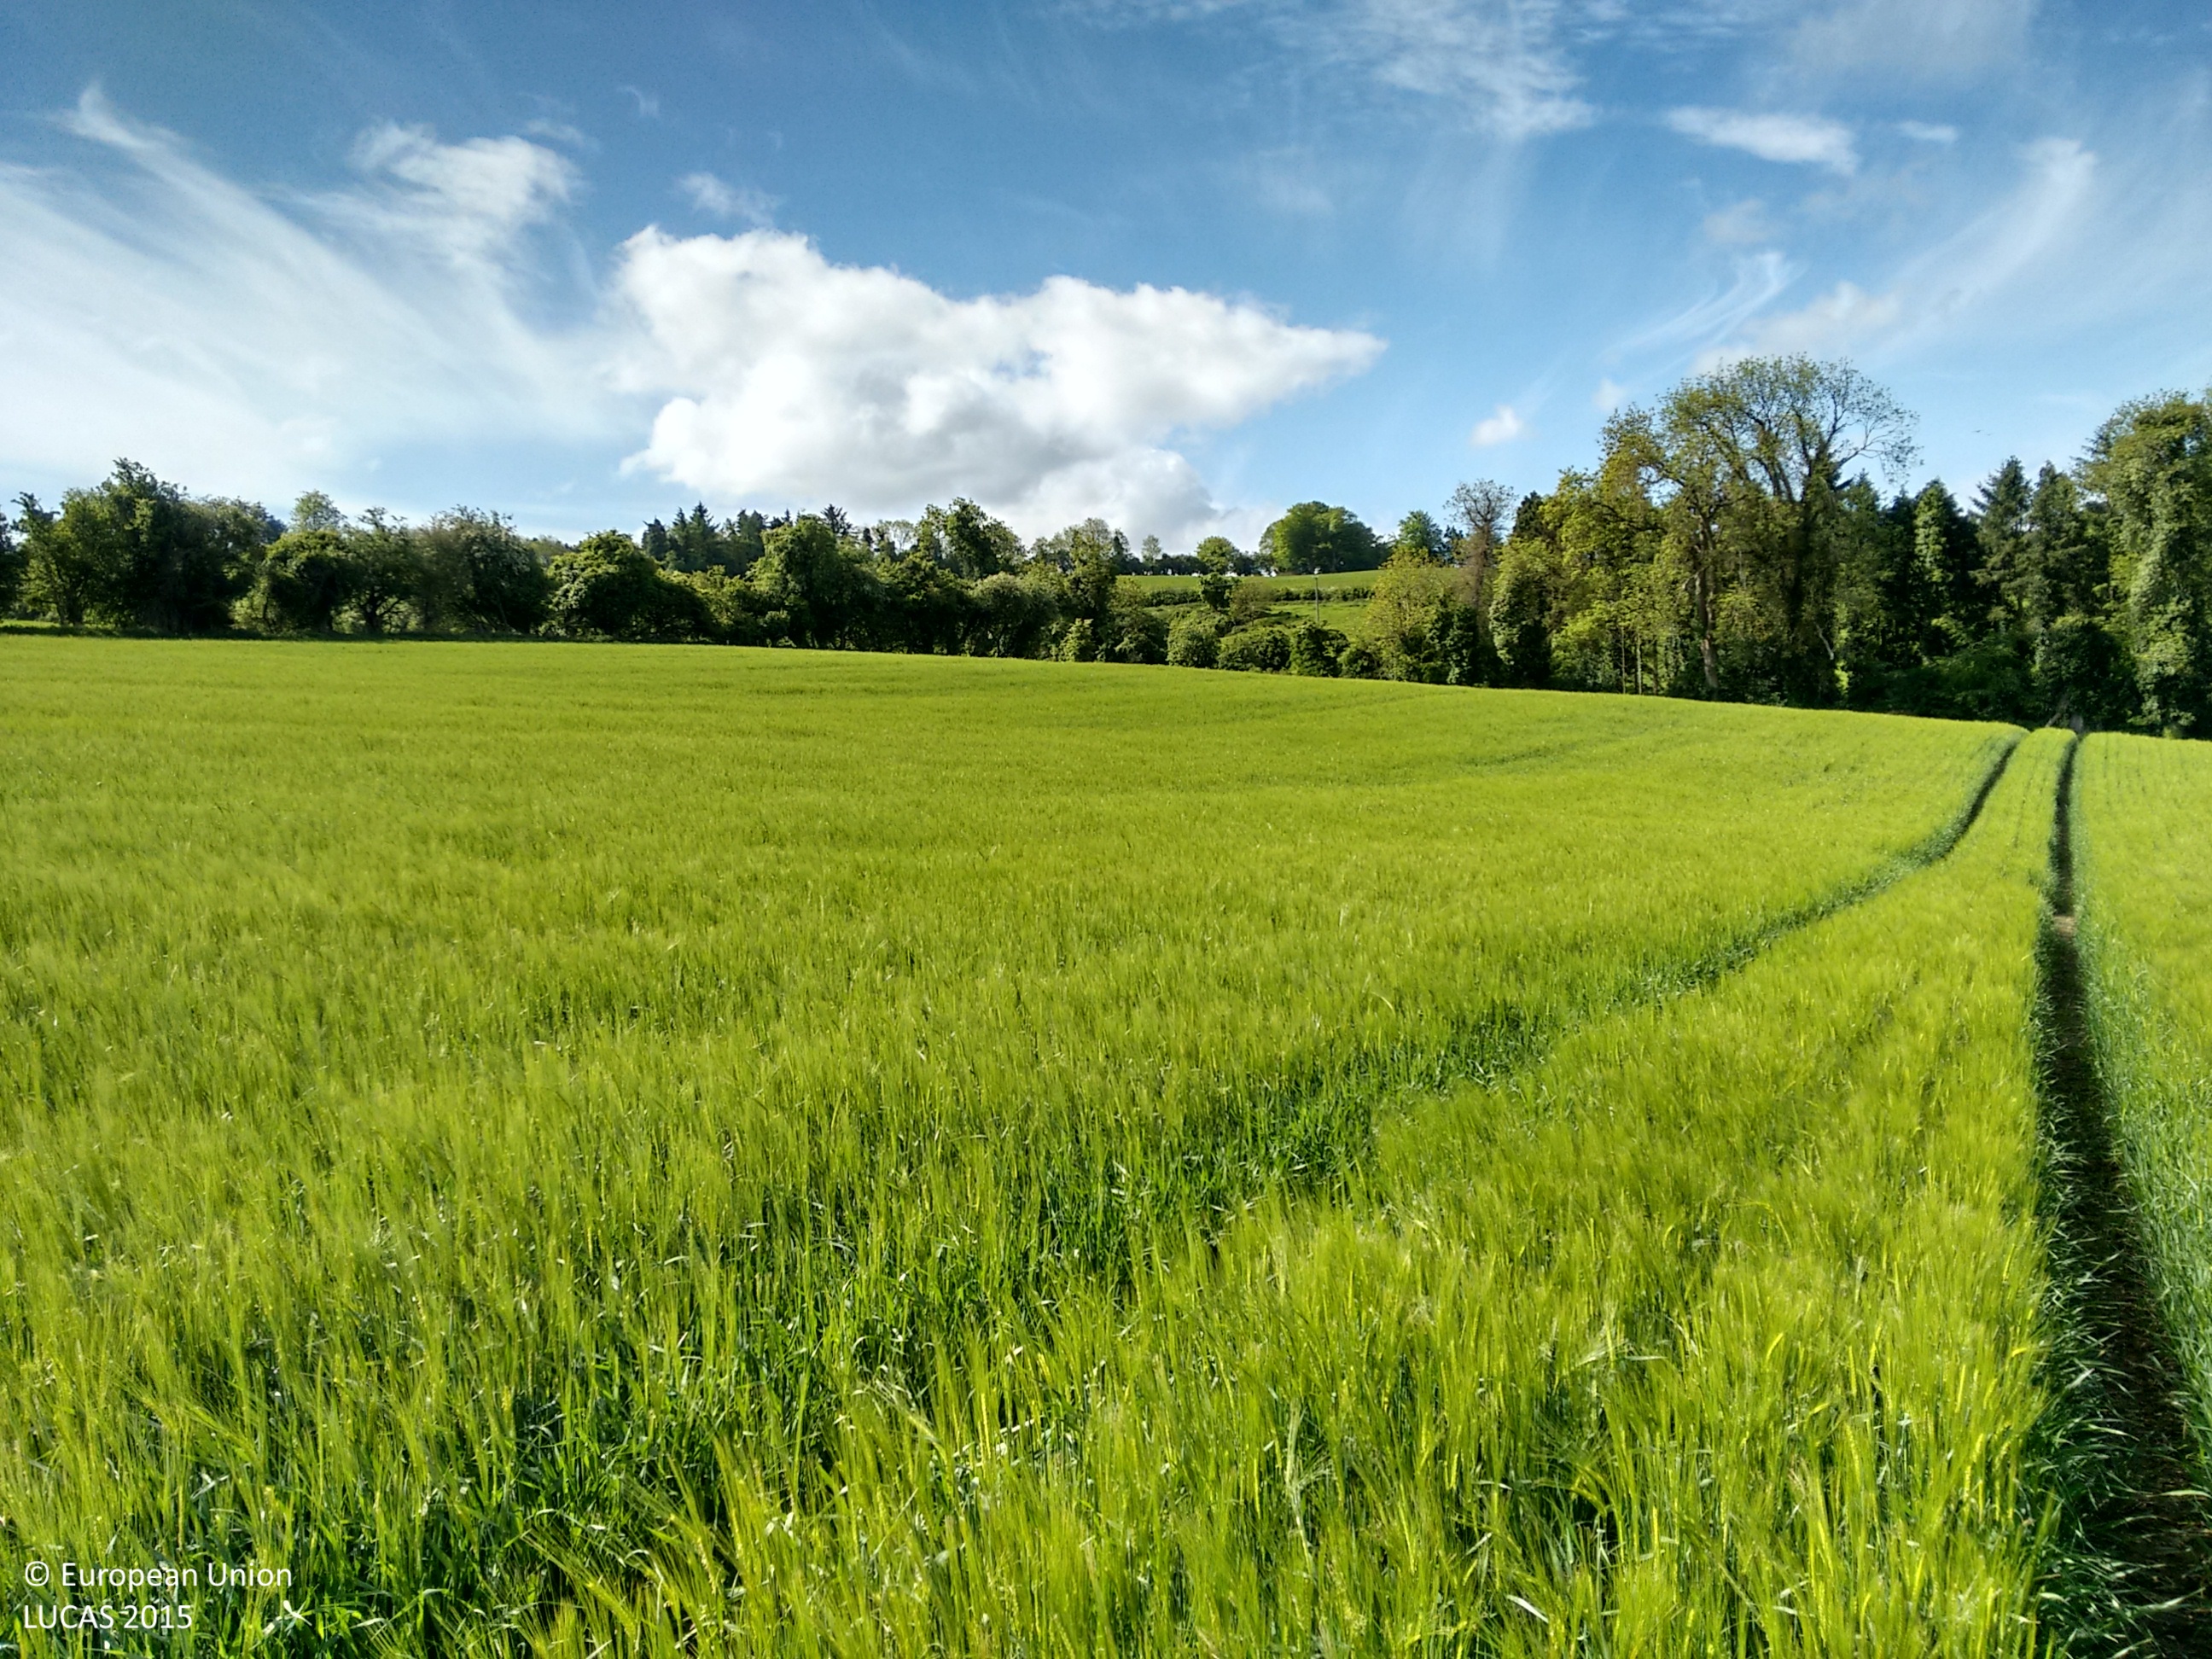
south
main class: Cropland
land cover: Common wheat
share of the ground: > 75 %
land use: Agriculture (excluding fallow land and kitchen gardens)
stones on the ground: < 10 %
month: June
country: IE
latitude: 53.1852
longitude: -6.5756
